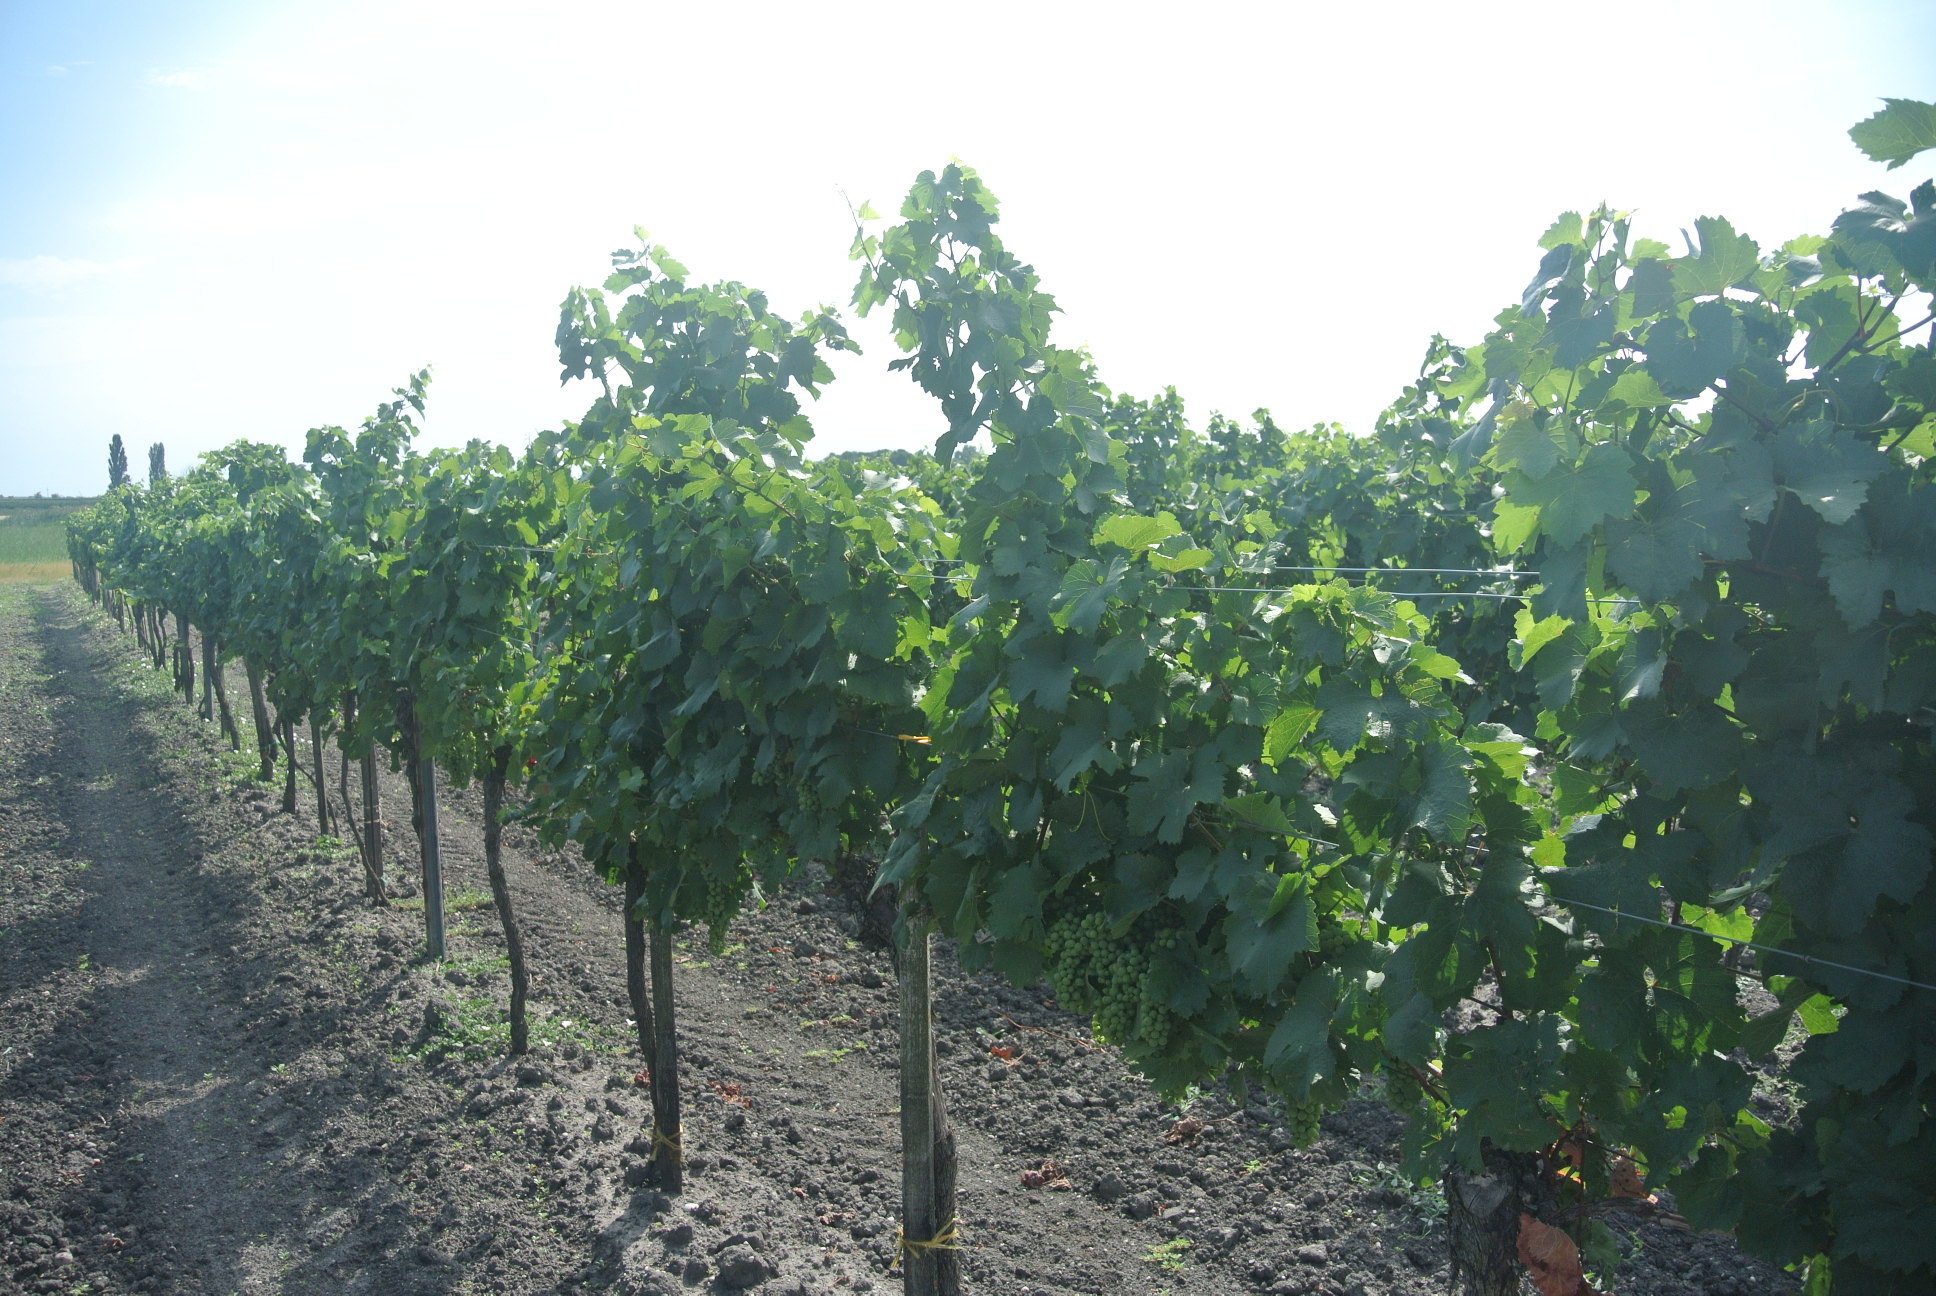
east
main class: Cropland
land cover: Vineyards
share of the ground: 25 - 50 %
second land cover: Other bare soil
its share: > 75 %
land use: Agriculture (excluding fallow land and kitchen gardens)
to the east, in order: Vineyards; Other bare soil; Grassland without tree/shrub cover; Inland marshes; Inland fresh water bodies
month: July
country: AT
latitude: 47.7234
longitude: 16.8181
